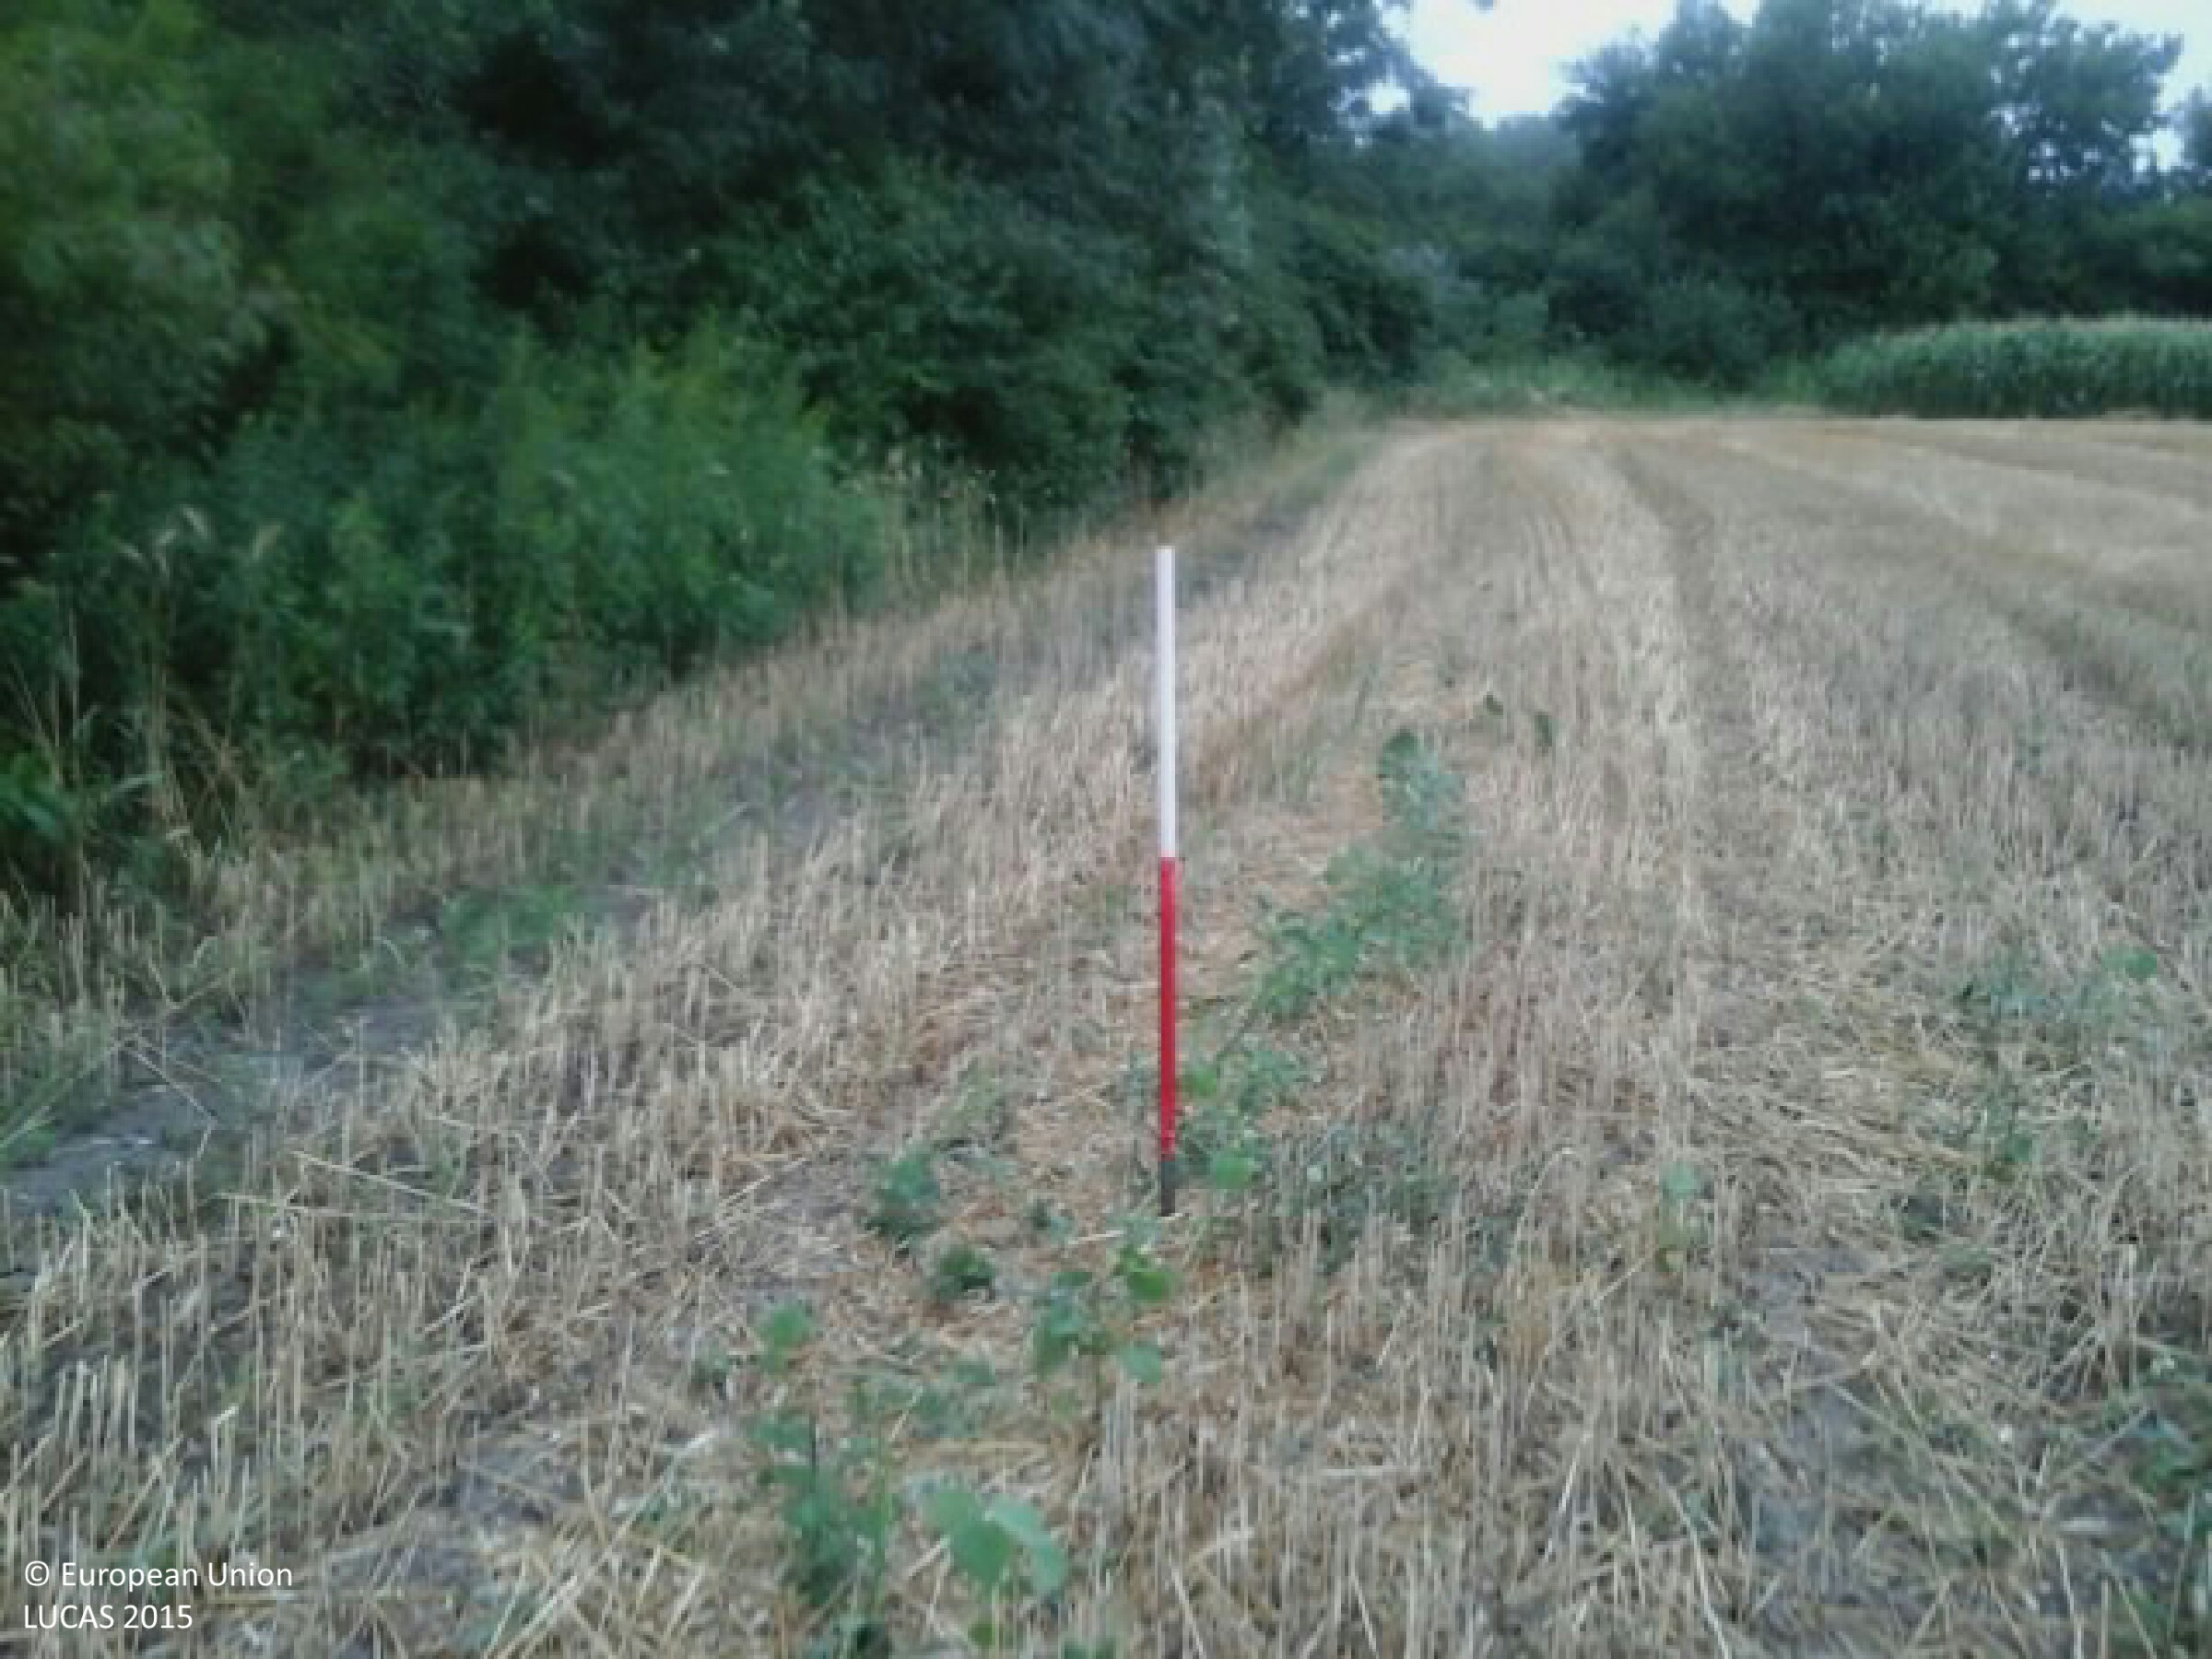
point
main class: Cropland
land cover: Rye
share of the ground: 50 - 75 %
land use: Agriculture (excluding fallow land and kitchen gardens)
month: July
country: HU
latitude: 46.3452
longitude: 18.8606
